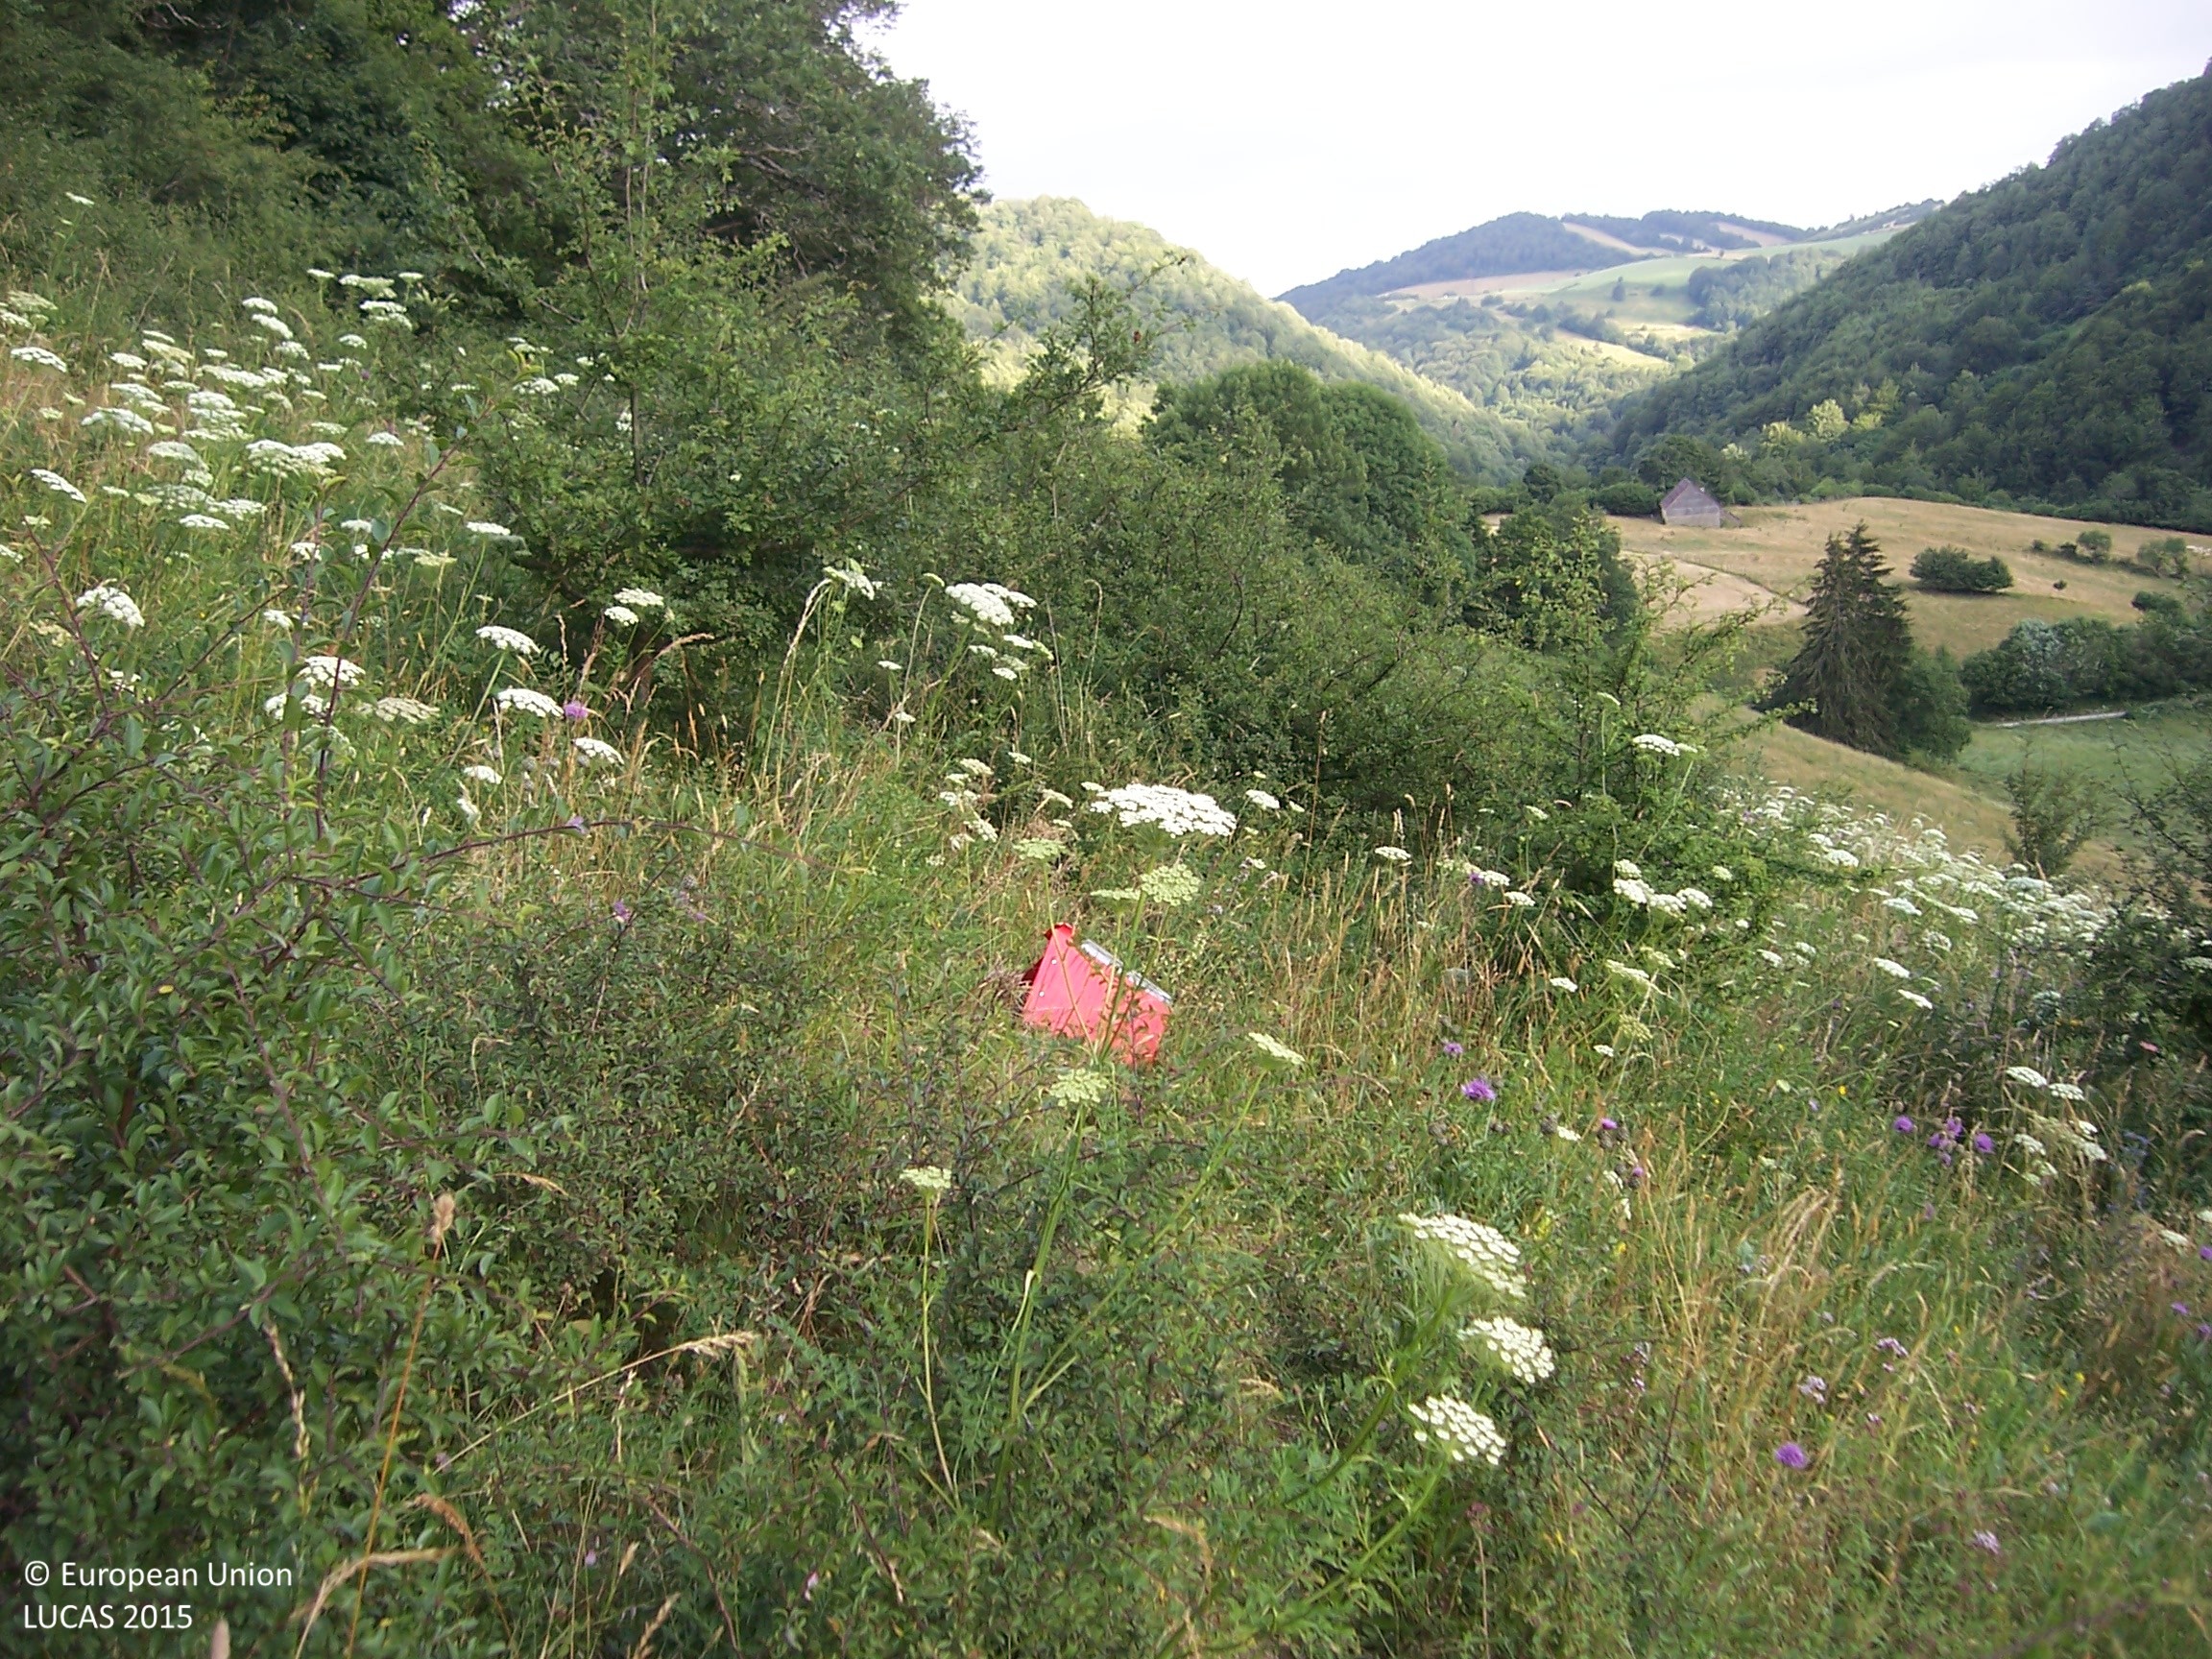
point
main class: Shrubland
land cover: Shrubland without tree cover
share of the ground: > 75 %
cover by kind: shrubs 60 %, herbaceous plants 40 %
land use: Agriculture (excluding fallow land and kitchen gardens)
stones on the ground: < 10 %
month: July
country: ES
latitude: 42.9868
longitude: -1.2831
